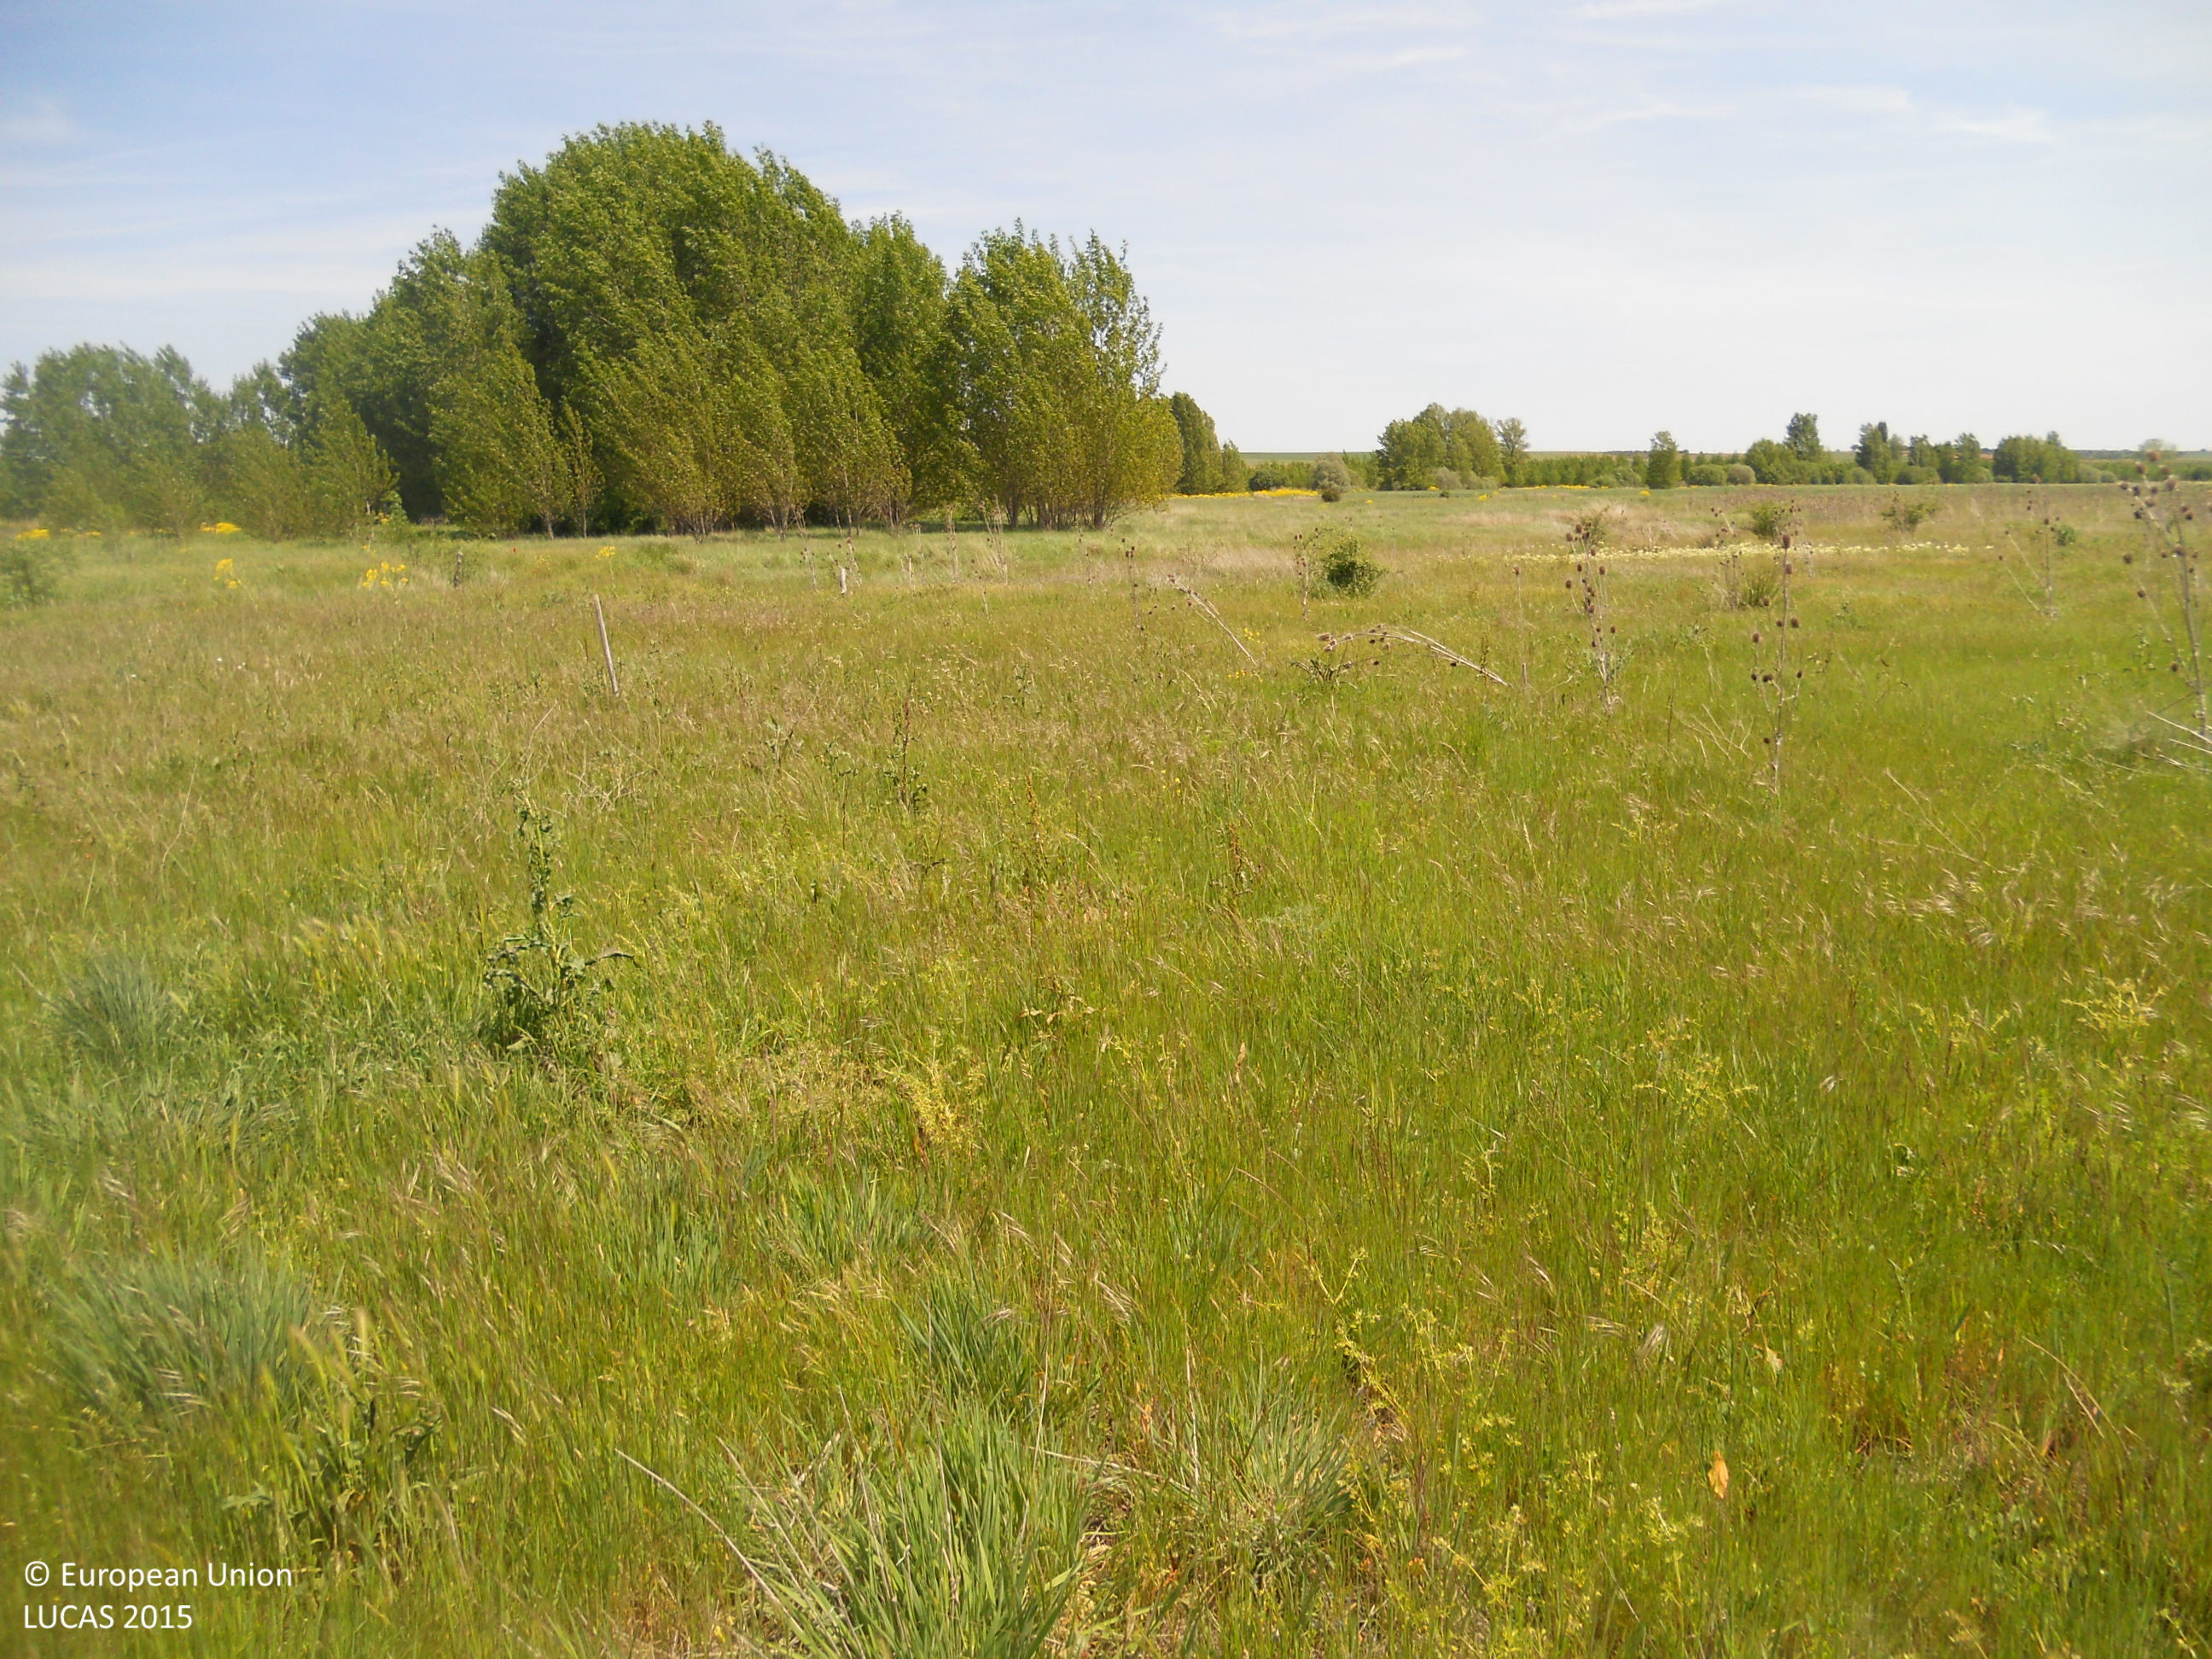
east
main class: Grassland
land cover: Grassland without tree/shrub cover
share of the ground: > 75 %
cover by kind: herbaceous plants 100 %
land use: Forestry
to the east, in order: Grassland without tree/shrub cover; Broadleaved woodland; Grassland without tree/shrub cover
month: May
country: ES
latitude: 42.3462
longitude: -5.2984
